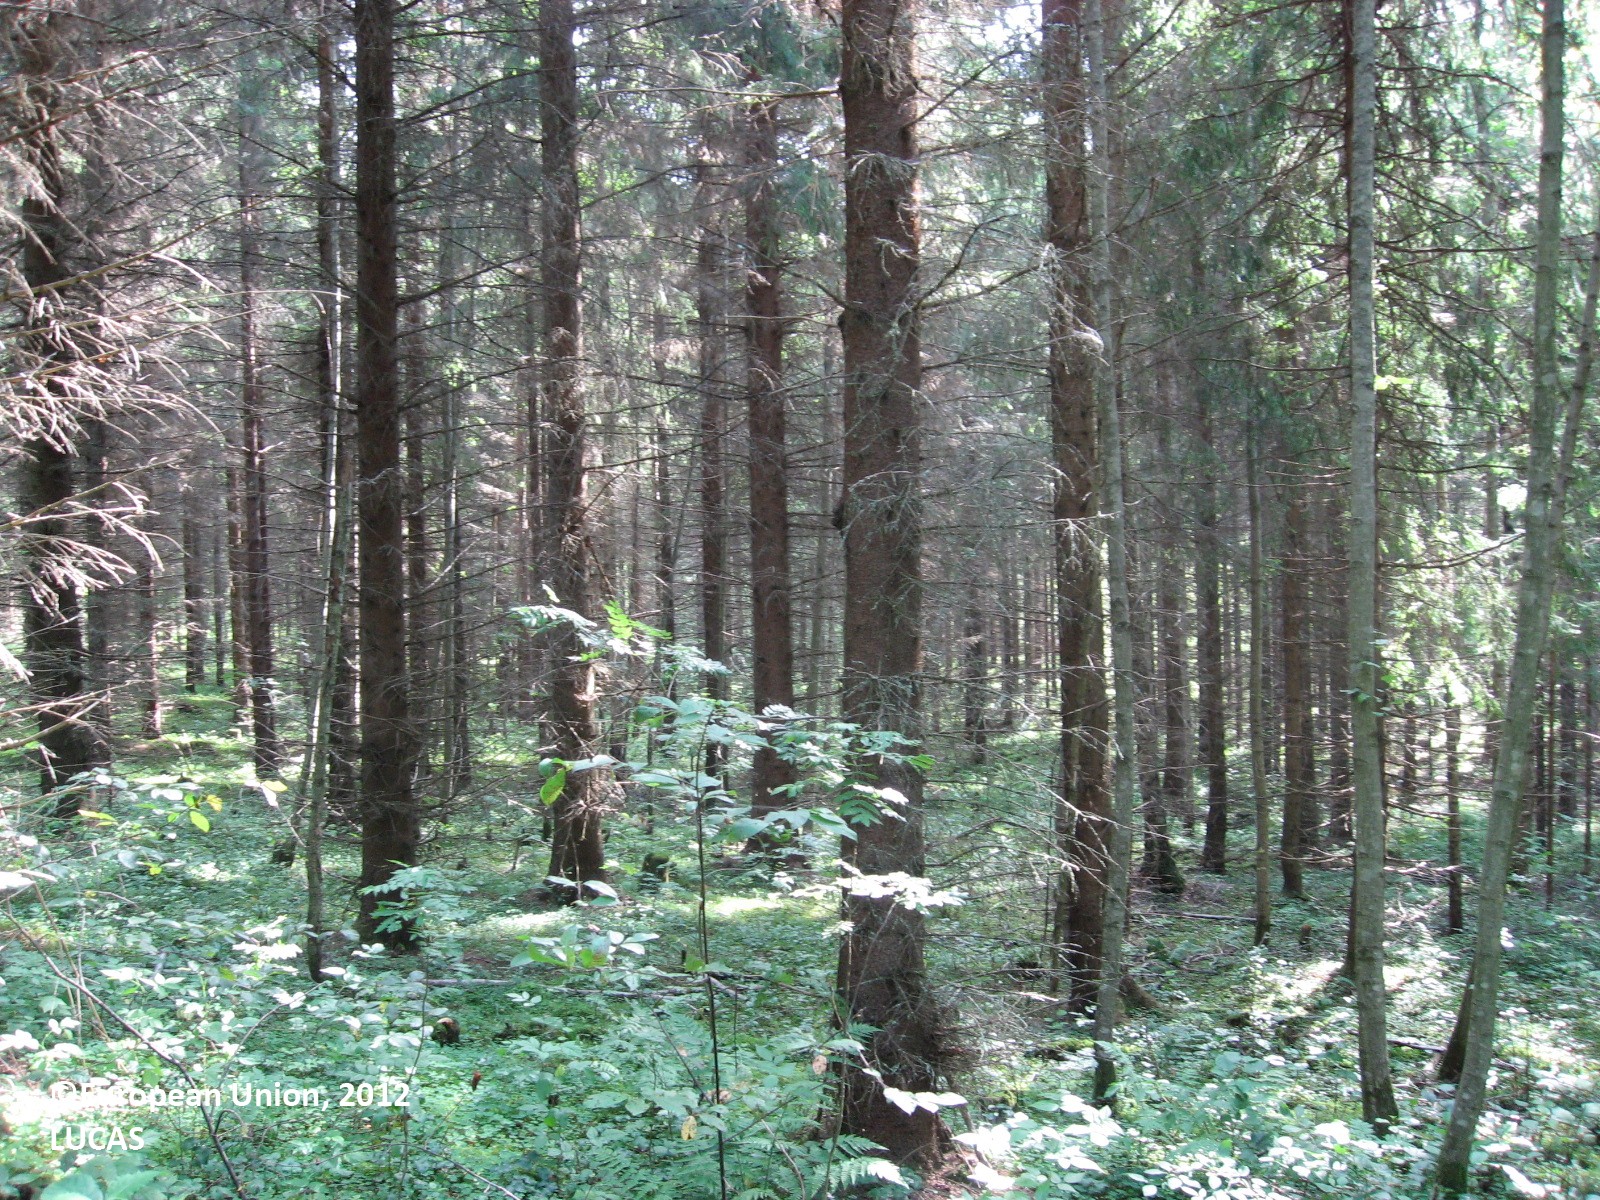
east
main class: Woodland
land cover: Spruce dominated coniferous woodland
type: boreal forest
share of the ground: > 75 %
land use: Forestry
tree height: > 5 m
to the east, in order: Spruce dominated coniferous woodland; Tracks; Spruce dominated coniferous woodland; Tracks; Spruce dominated mixed woodland; Other mixed woodland
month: August
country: FI
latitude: 61.5403
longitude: 25.8750
